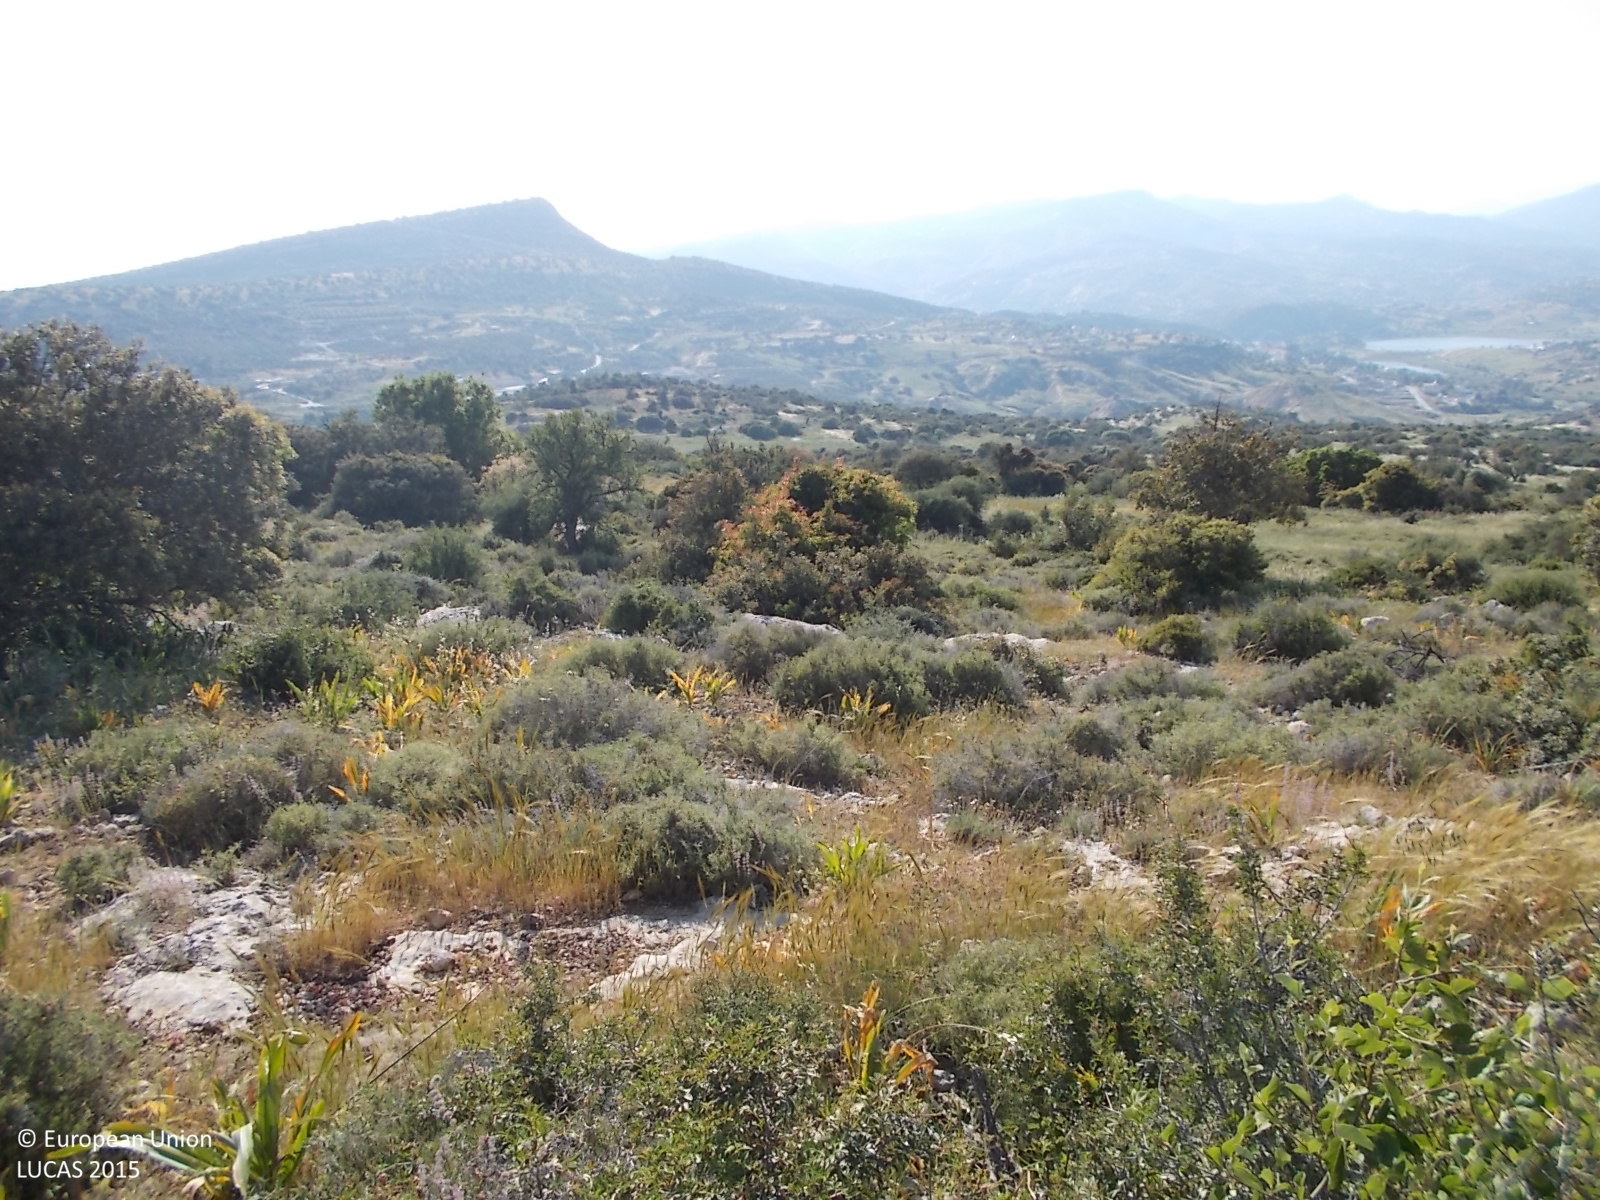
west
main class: Shrubland
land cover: Shrubland with sparse tree cover
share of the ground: > 75 %
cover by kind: shrubs 90 %, broadleaved forest trees 5 %, consolidated bare surface 5 %
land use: Semi-natural and natural areas not in use
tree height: < 5 m
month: April
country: CY
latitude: 34.7447
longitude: 33.1190
